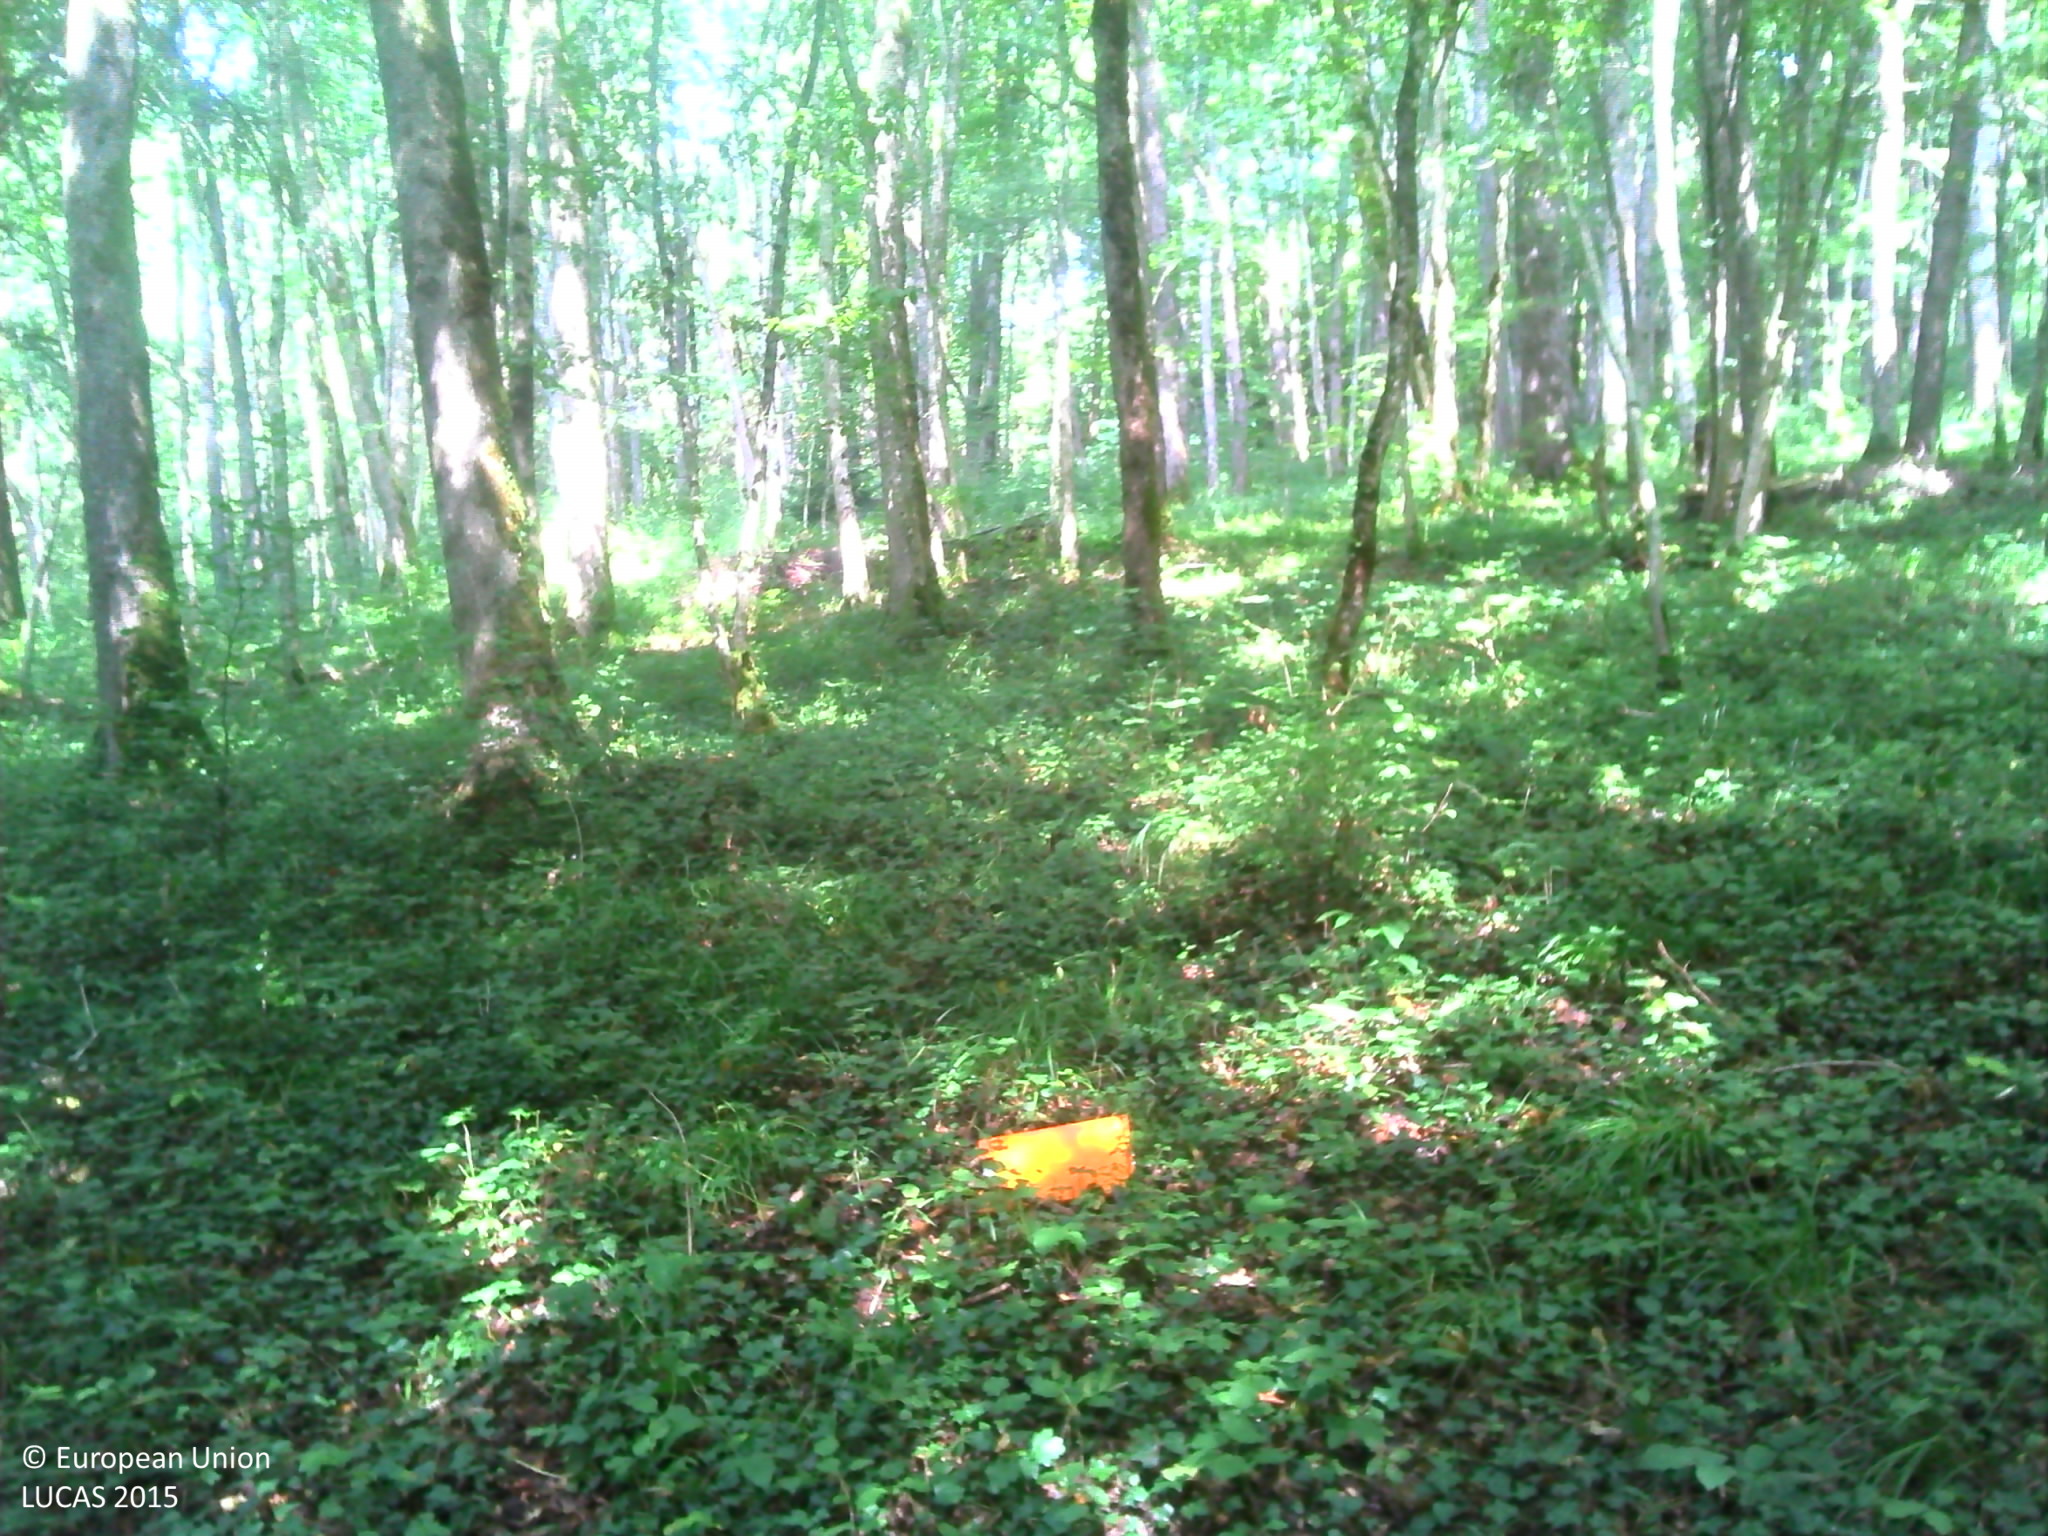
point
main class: Woodland
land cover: Broadleaved woodland
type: mesophytic deciduous forest
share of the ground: > 75 %
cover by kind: broadleaved forest trees 90 %, herbaceous plants 10 %
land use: Forestry
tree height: > 5 m
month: September
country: FR
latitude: 47.4404
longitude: 6.8591
